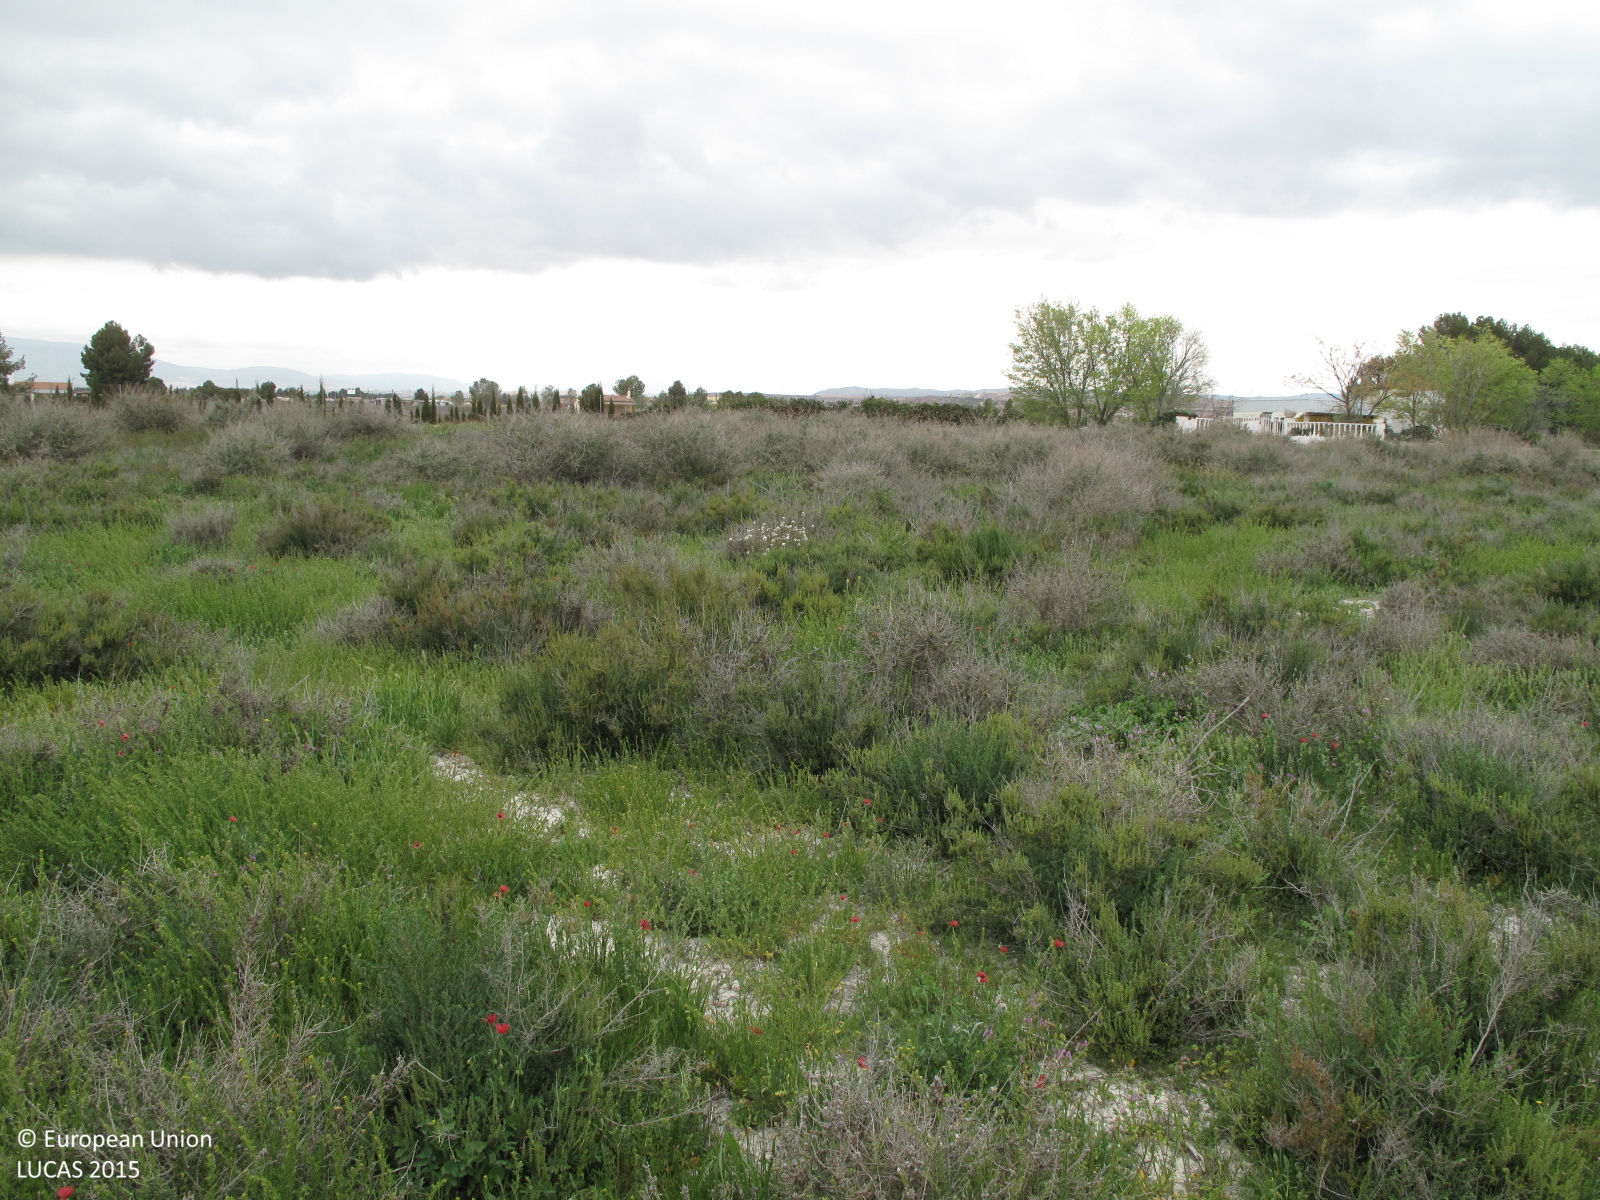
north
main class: Shrubland
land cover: Shrubland without tree cover
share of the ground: 50 - 75 %
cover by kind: shrubs 40 %, herbaceous plants 30 %, consolidated bare surface 30 %
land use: Semi-natural and natural areas not in use
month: April
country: ES
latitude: 38.6163
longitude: -0.9124
